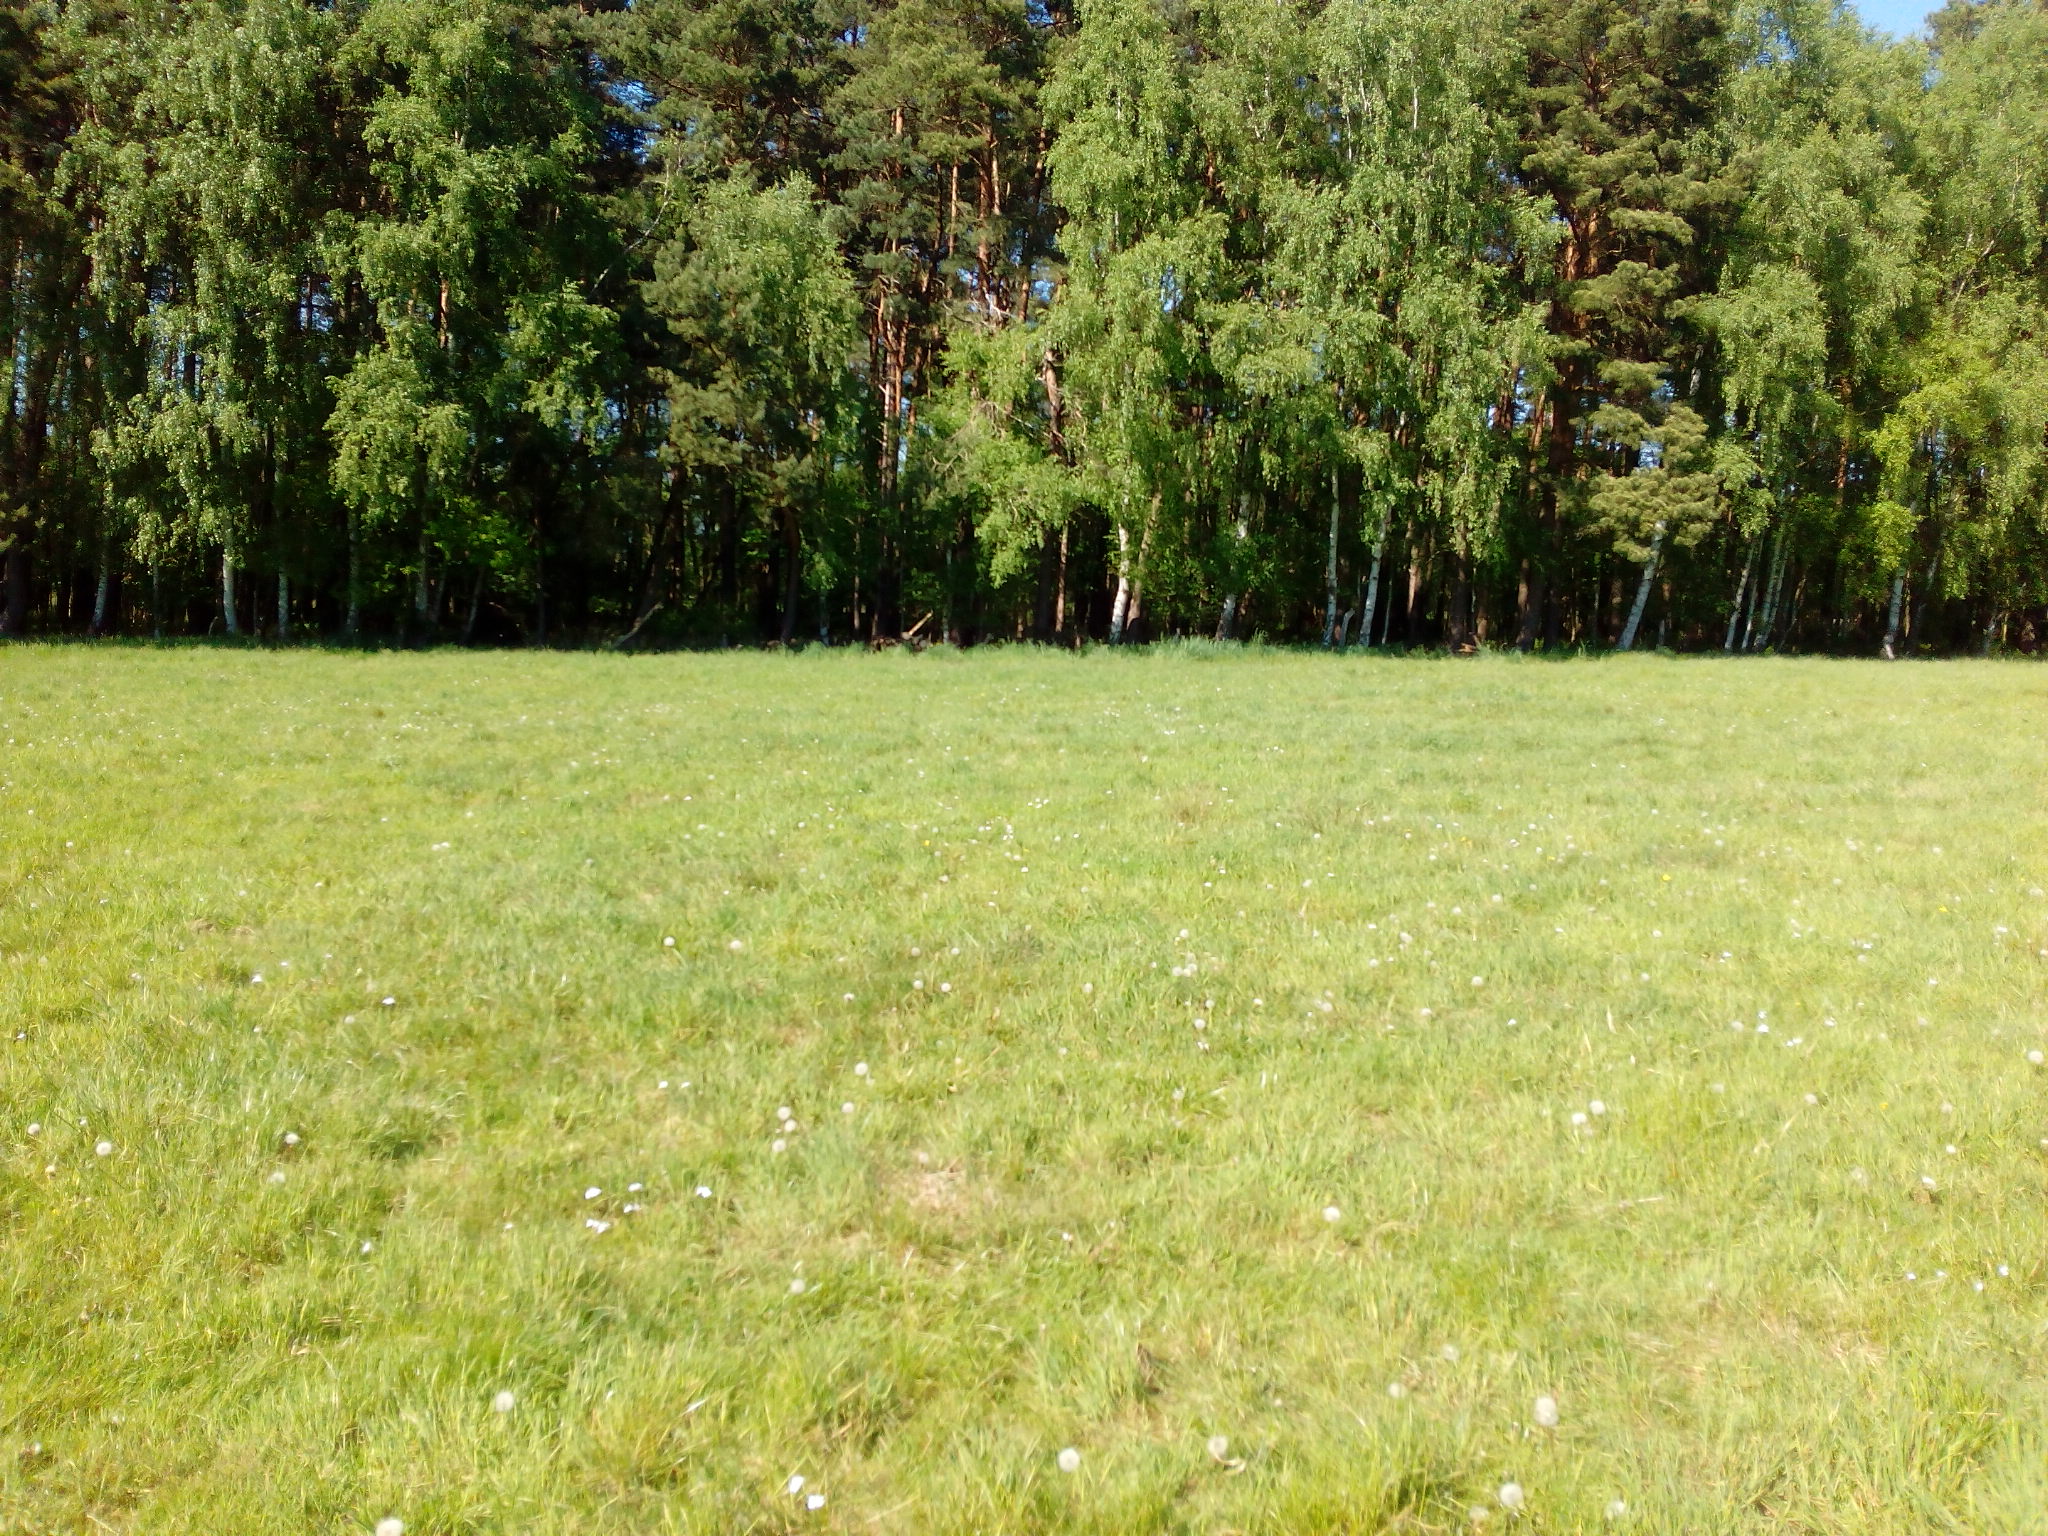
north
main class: Grassland
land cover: Grassland without tree/shrub cover
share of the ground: > 75 %
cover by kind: herbaceous plants 100 %
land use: Agriculture (excluding fallow land and kitchen gardens)
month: May
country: DE
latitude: 52.5565
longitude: 9.6019
